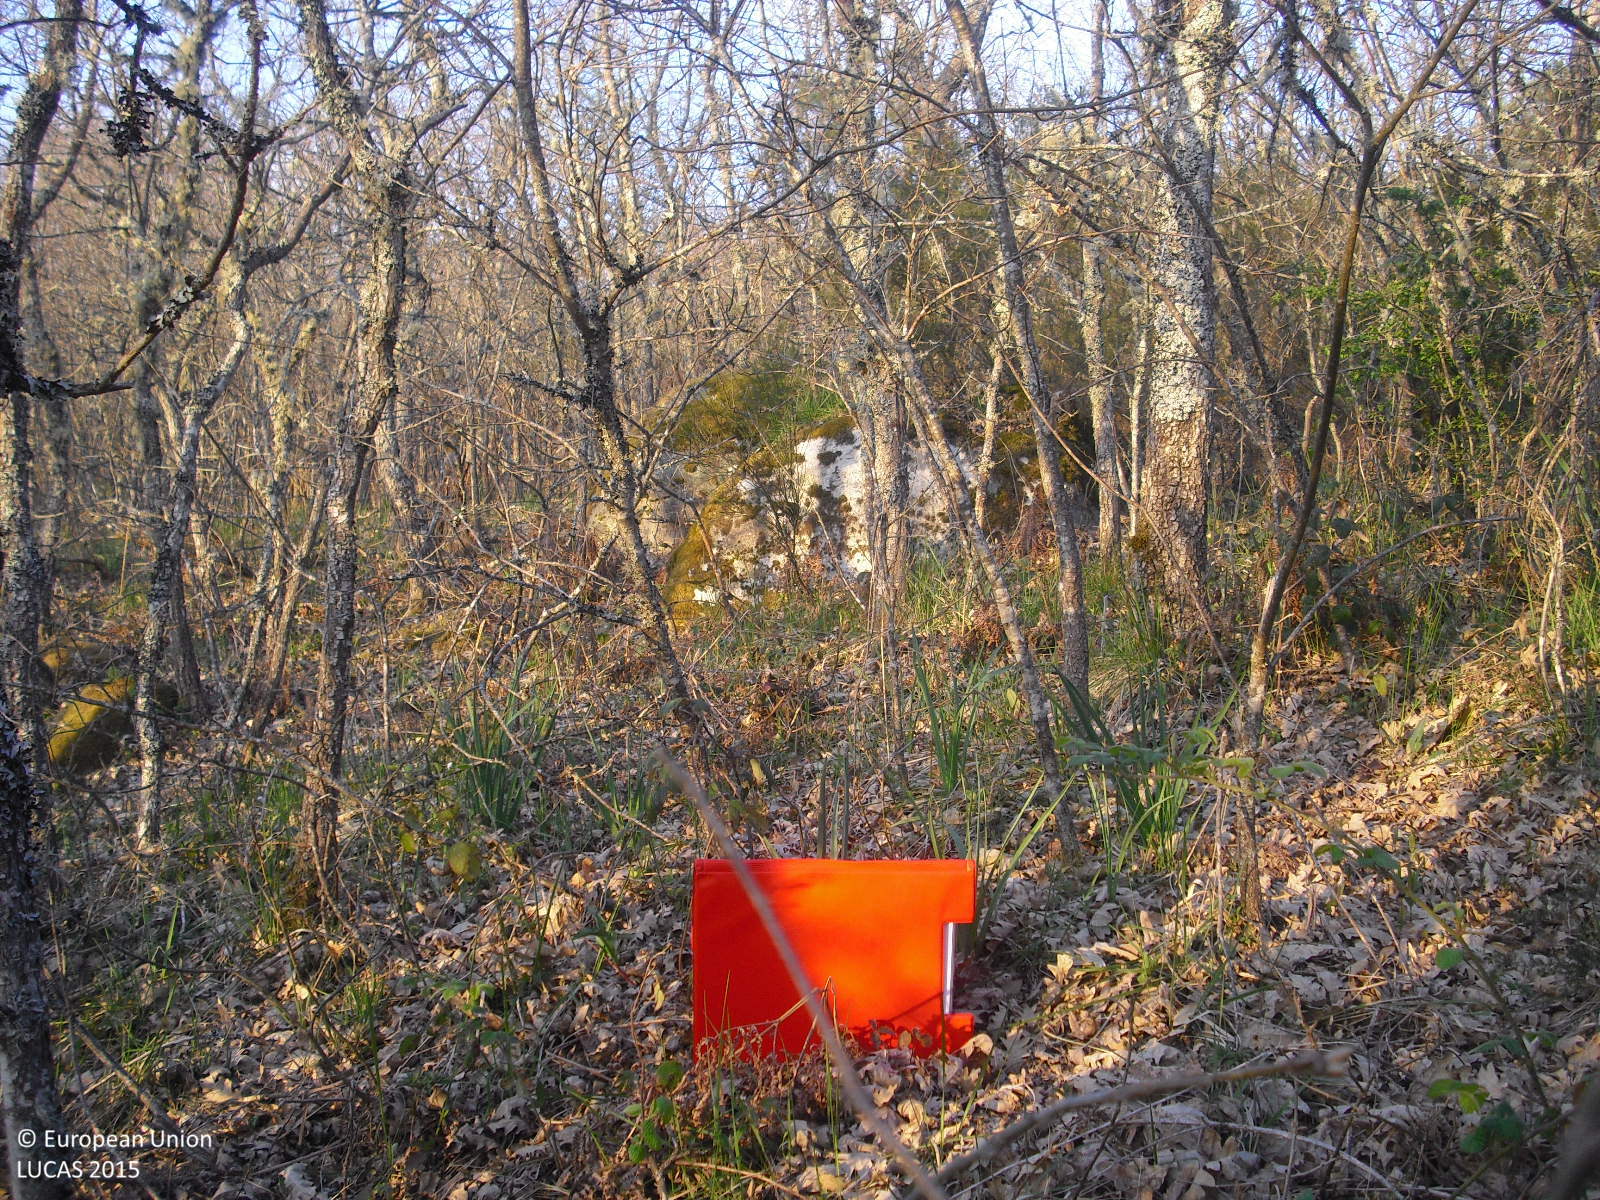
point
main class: Woodland
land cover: Broadleaved woodland
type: thermophilous deciduous forest
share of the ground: > 75 %
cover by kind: broadleaved forest trees 80 %, shrubs 10 %, herbaceous plants 5 %, consolidated bare surface 5 %
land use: Forestry
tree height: > 5 m
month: April
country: ES
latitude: 41.9628
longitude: -7.8194
